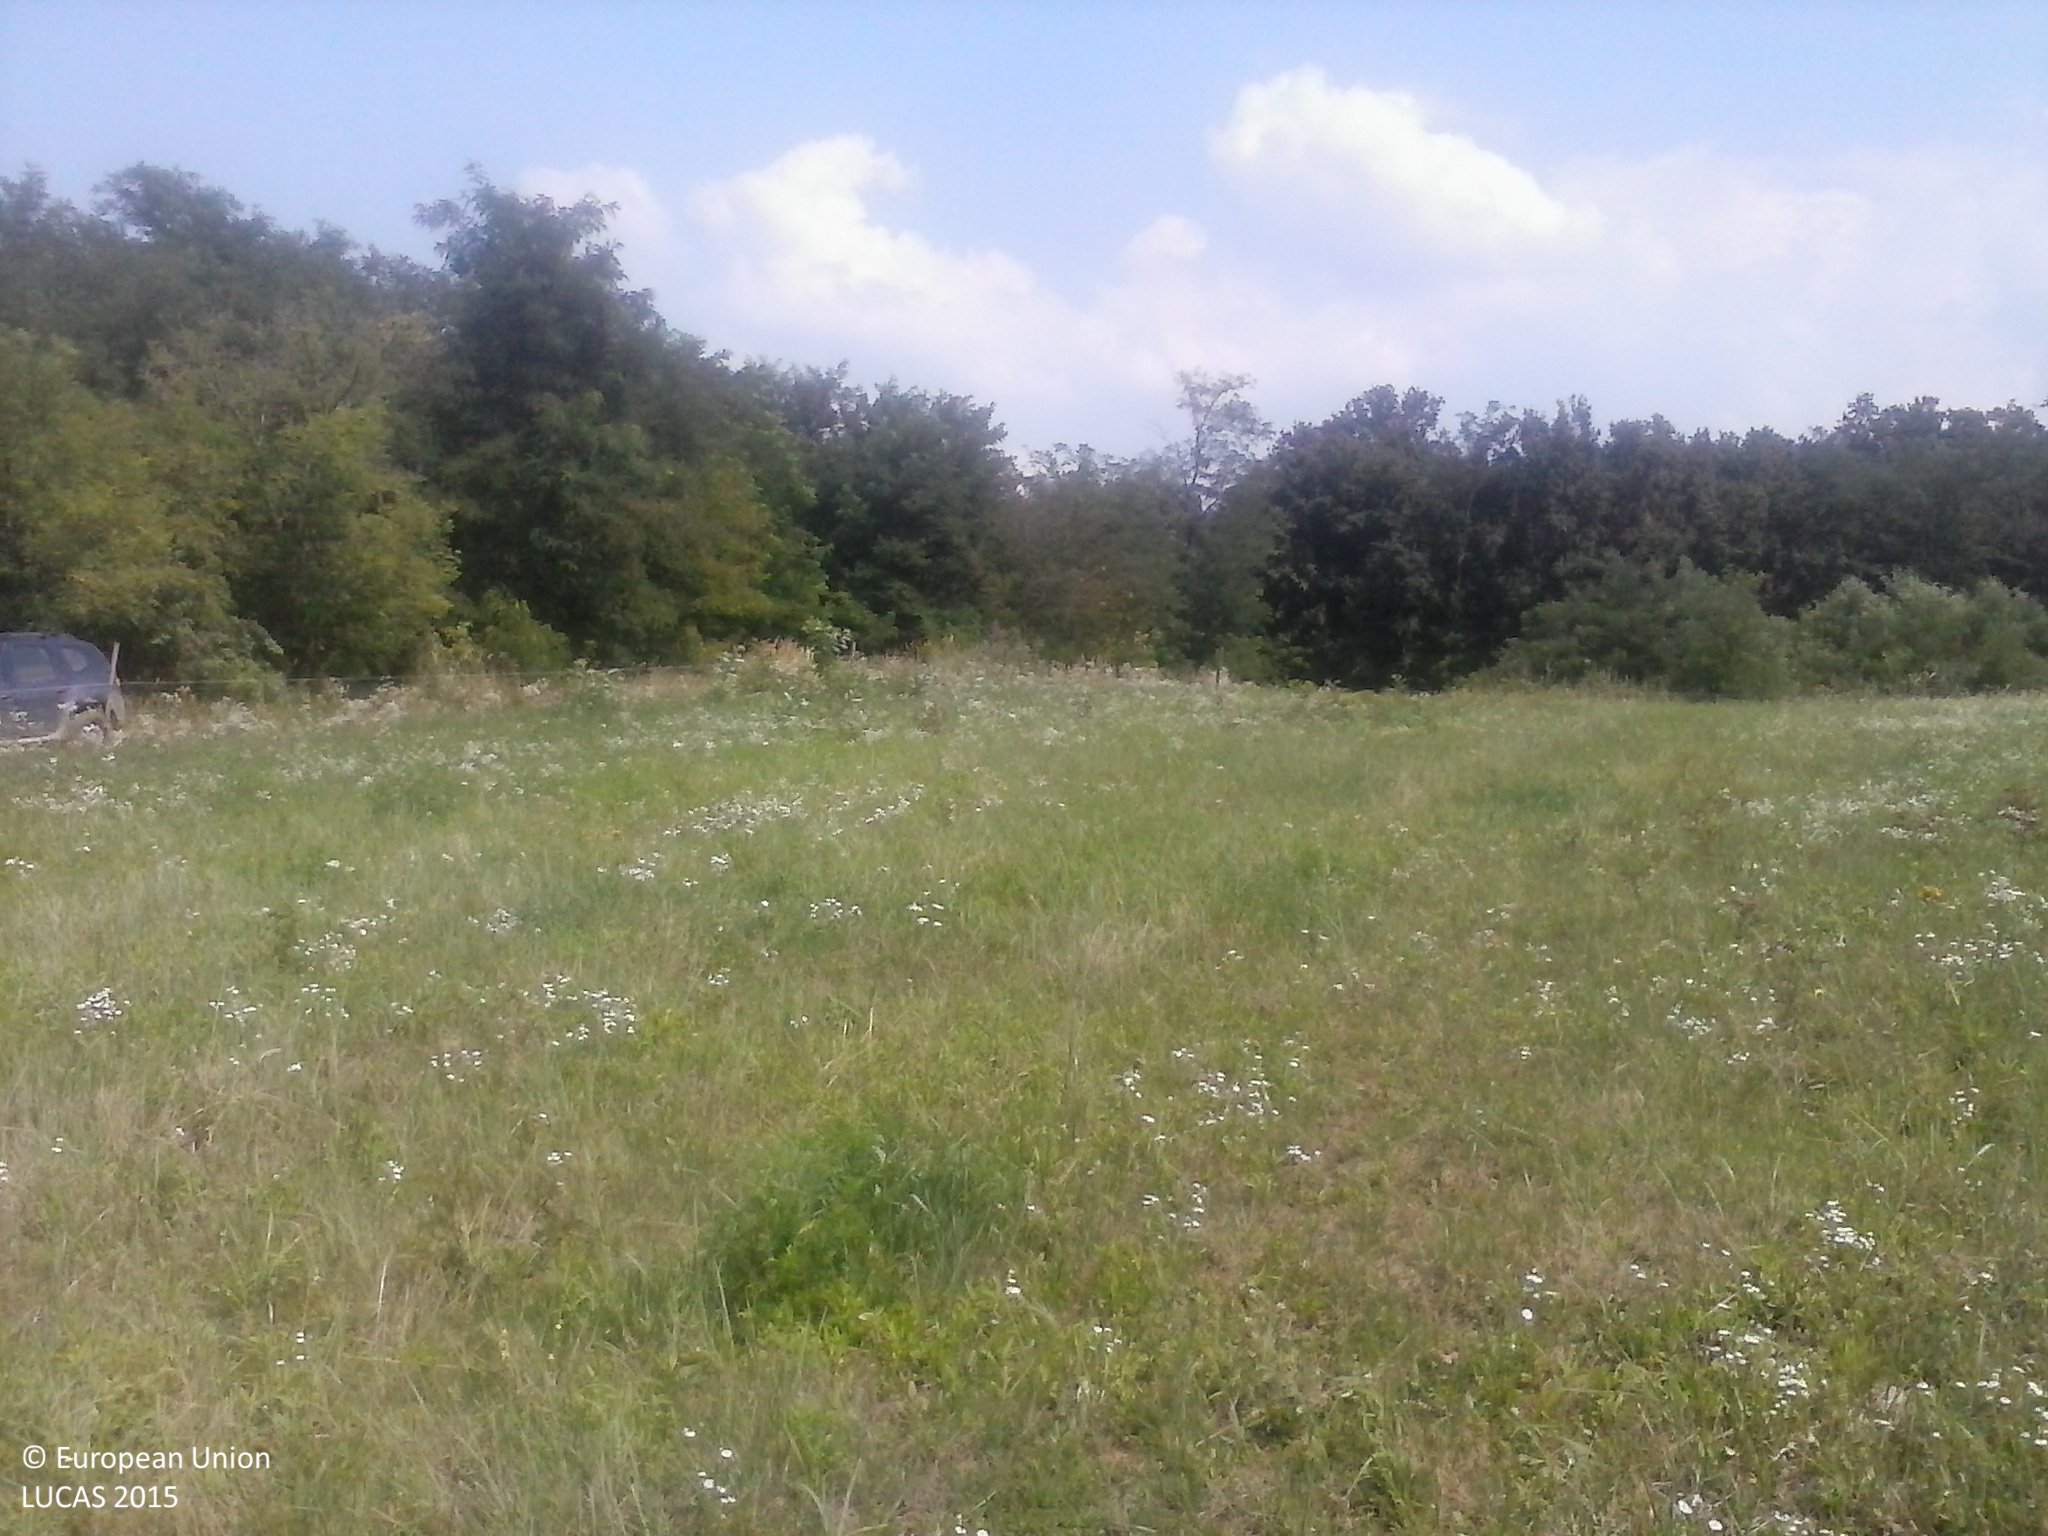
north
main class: Grassland
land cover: Grassland without tree/shrub cover
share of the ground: > 75 %
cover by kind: herbaceous plants 100 %
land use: Agriculture (excluding fallow land and kitchen gardens)
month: August
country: HU
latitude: 46.1339
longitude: 17.8622
